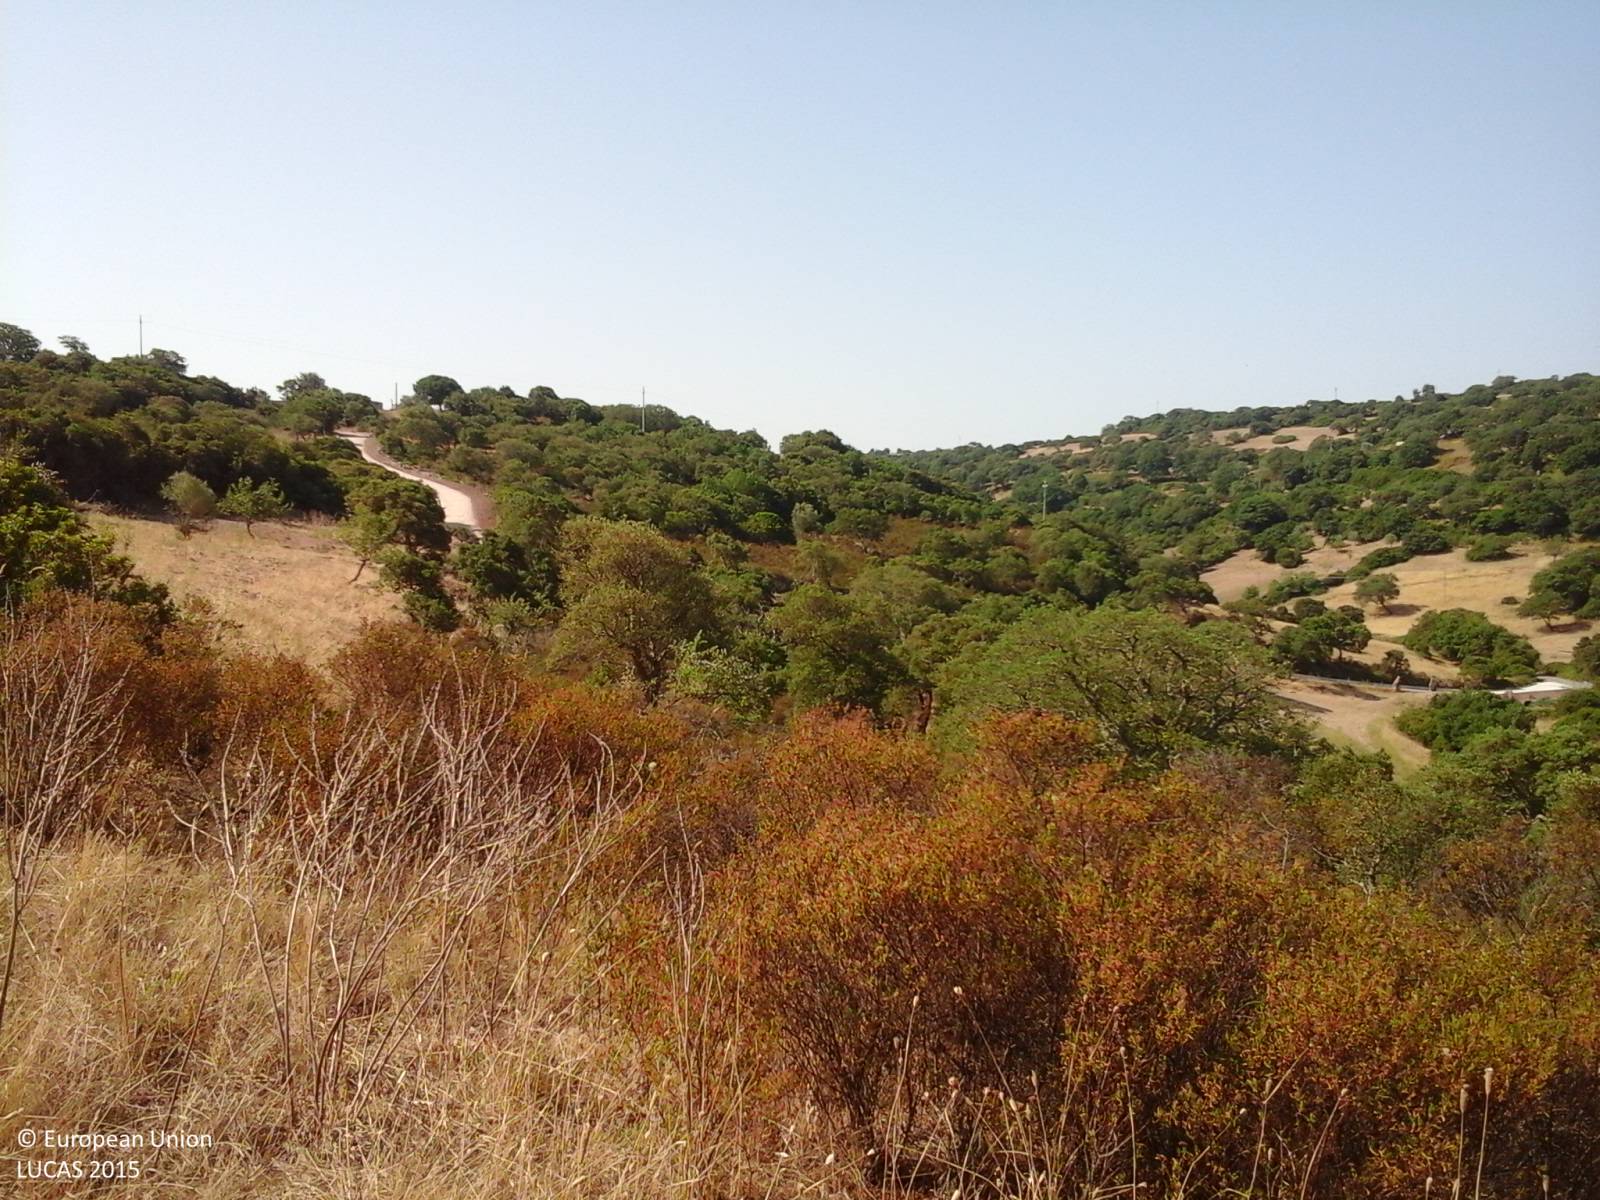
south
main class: Grassland
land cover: Grassland with sparse tree/shrub cover
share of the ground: > 75 %
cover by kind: herbaceous plants 85 %, shrubs 10 %, broadleaved forest trees 5 %
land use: Agriculture (excluding fallow land and kitchen gardens)
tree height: < 5 m
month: July
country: IT
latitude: 39.9171
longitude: 8.8947
